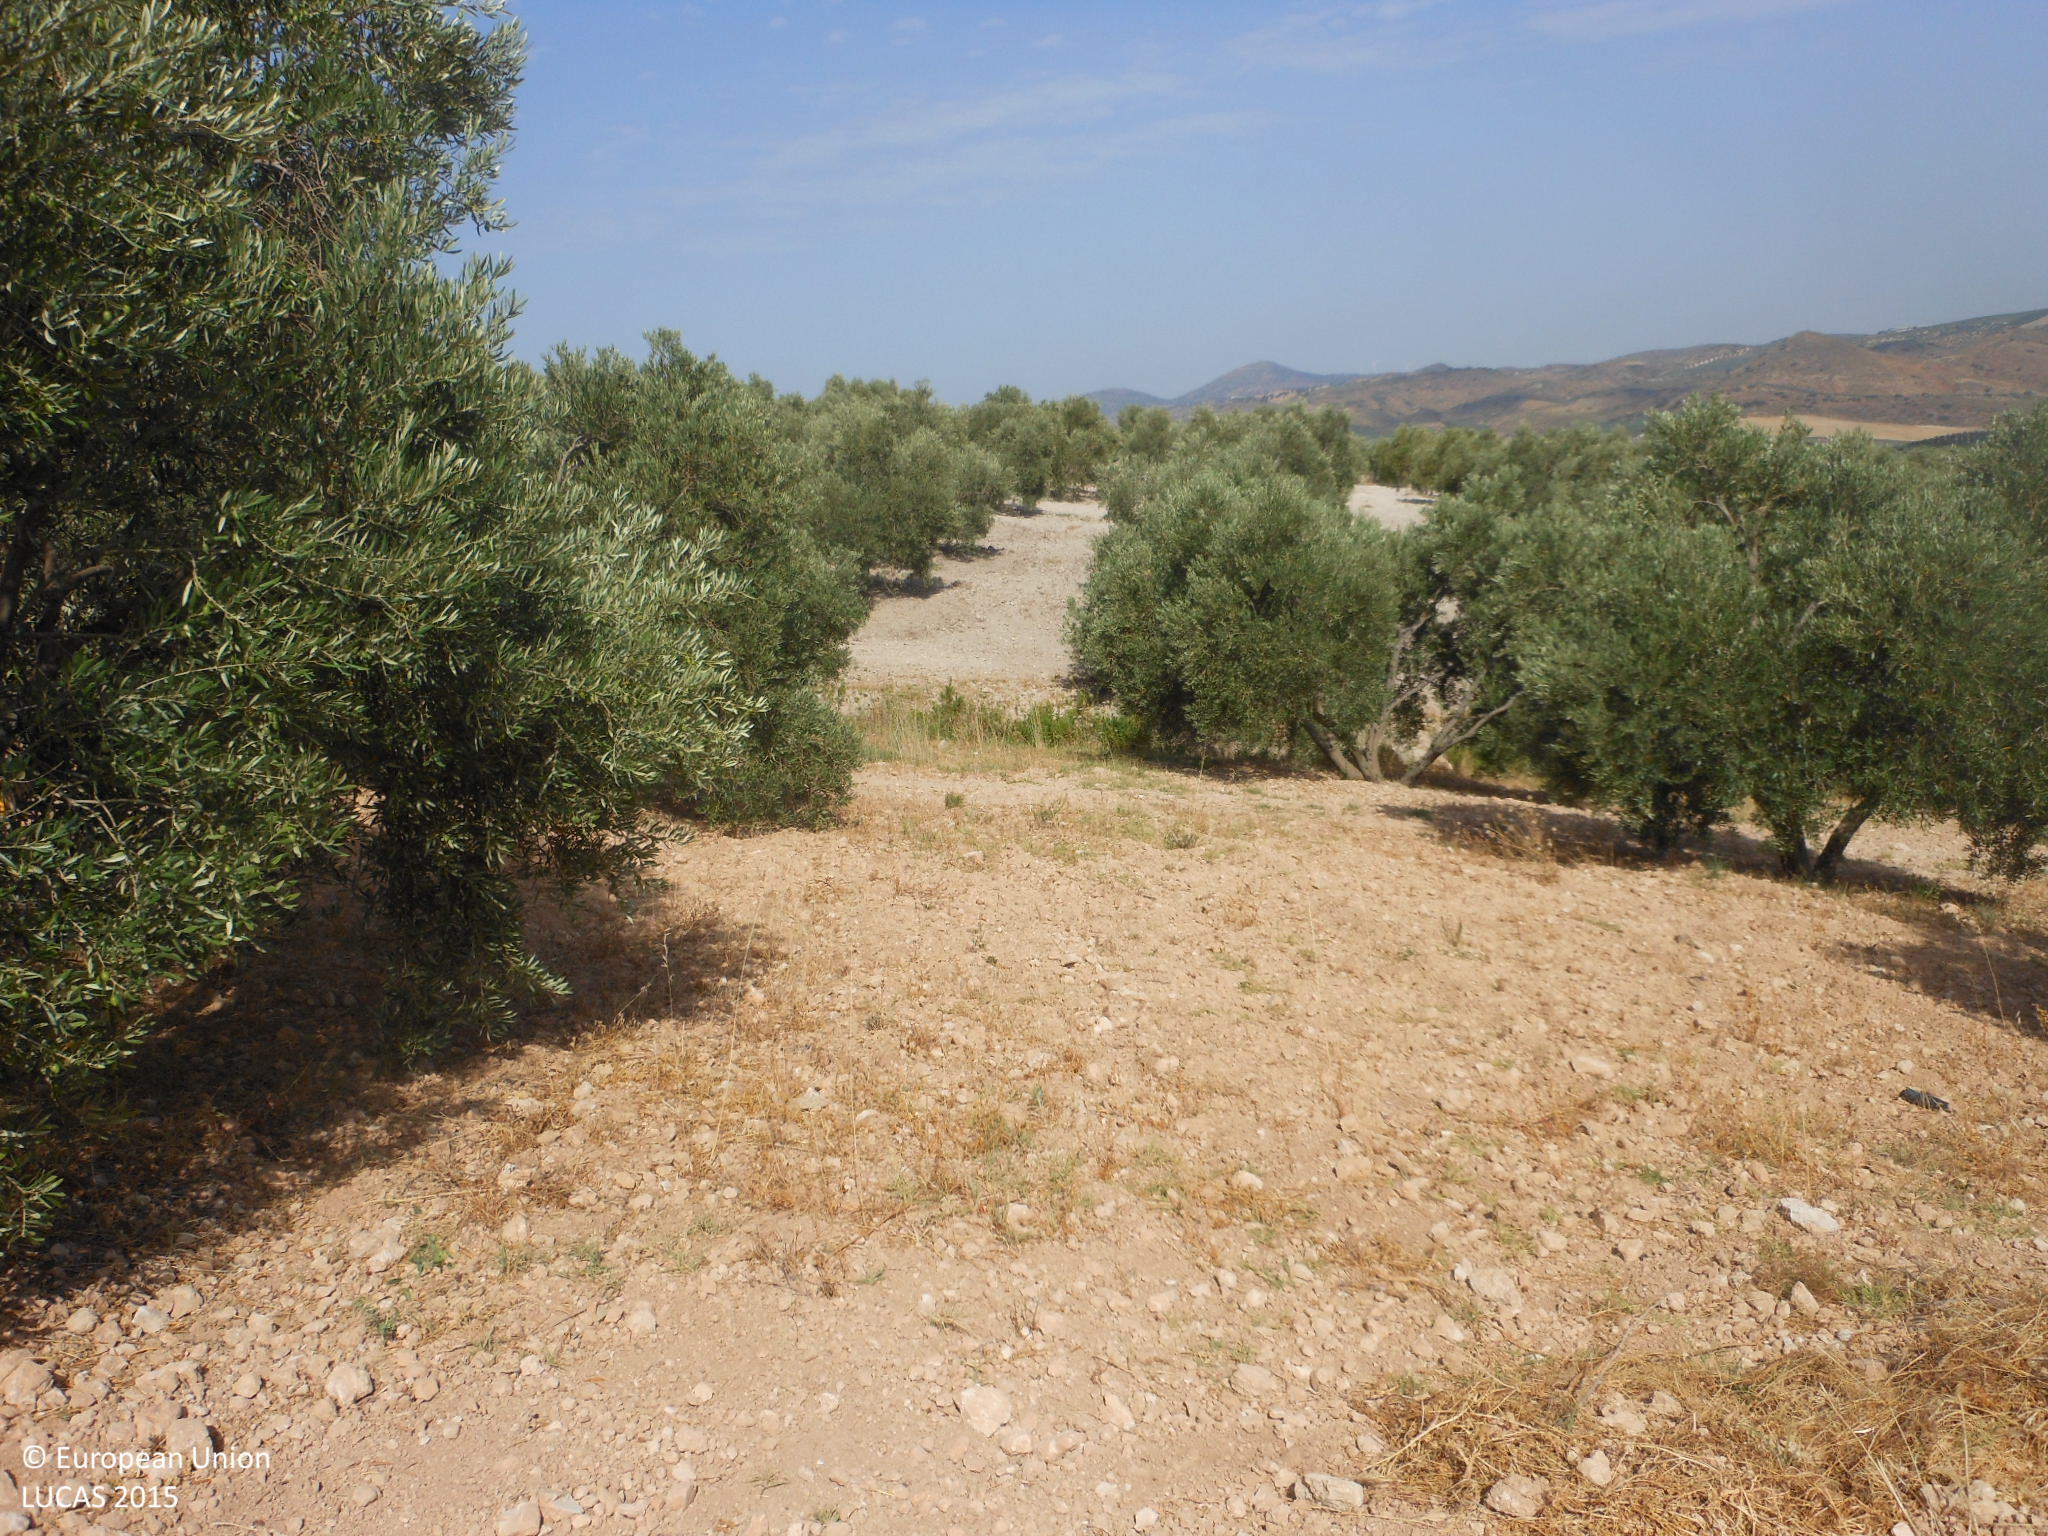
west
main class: Cropland
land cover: Olive groves
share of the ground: 25 - 50 %
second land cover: Other bare soil
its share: > 75 %
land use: Agriculture (excluding fallow land and kitchen gardens)
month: July
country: ES
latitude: 37.0987
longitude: -5.0248
